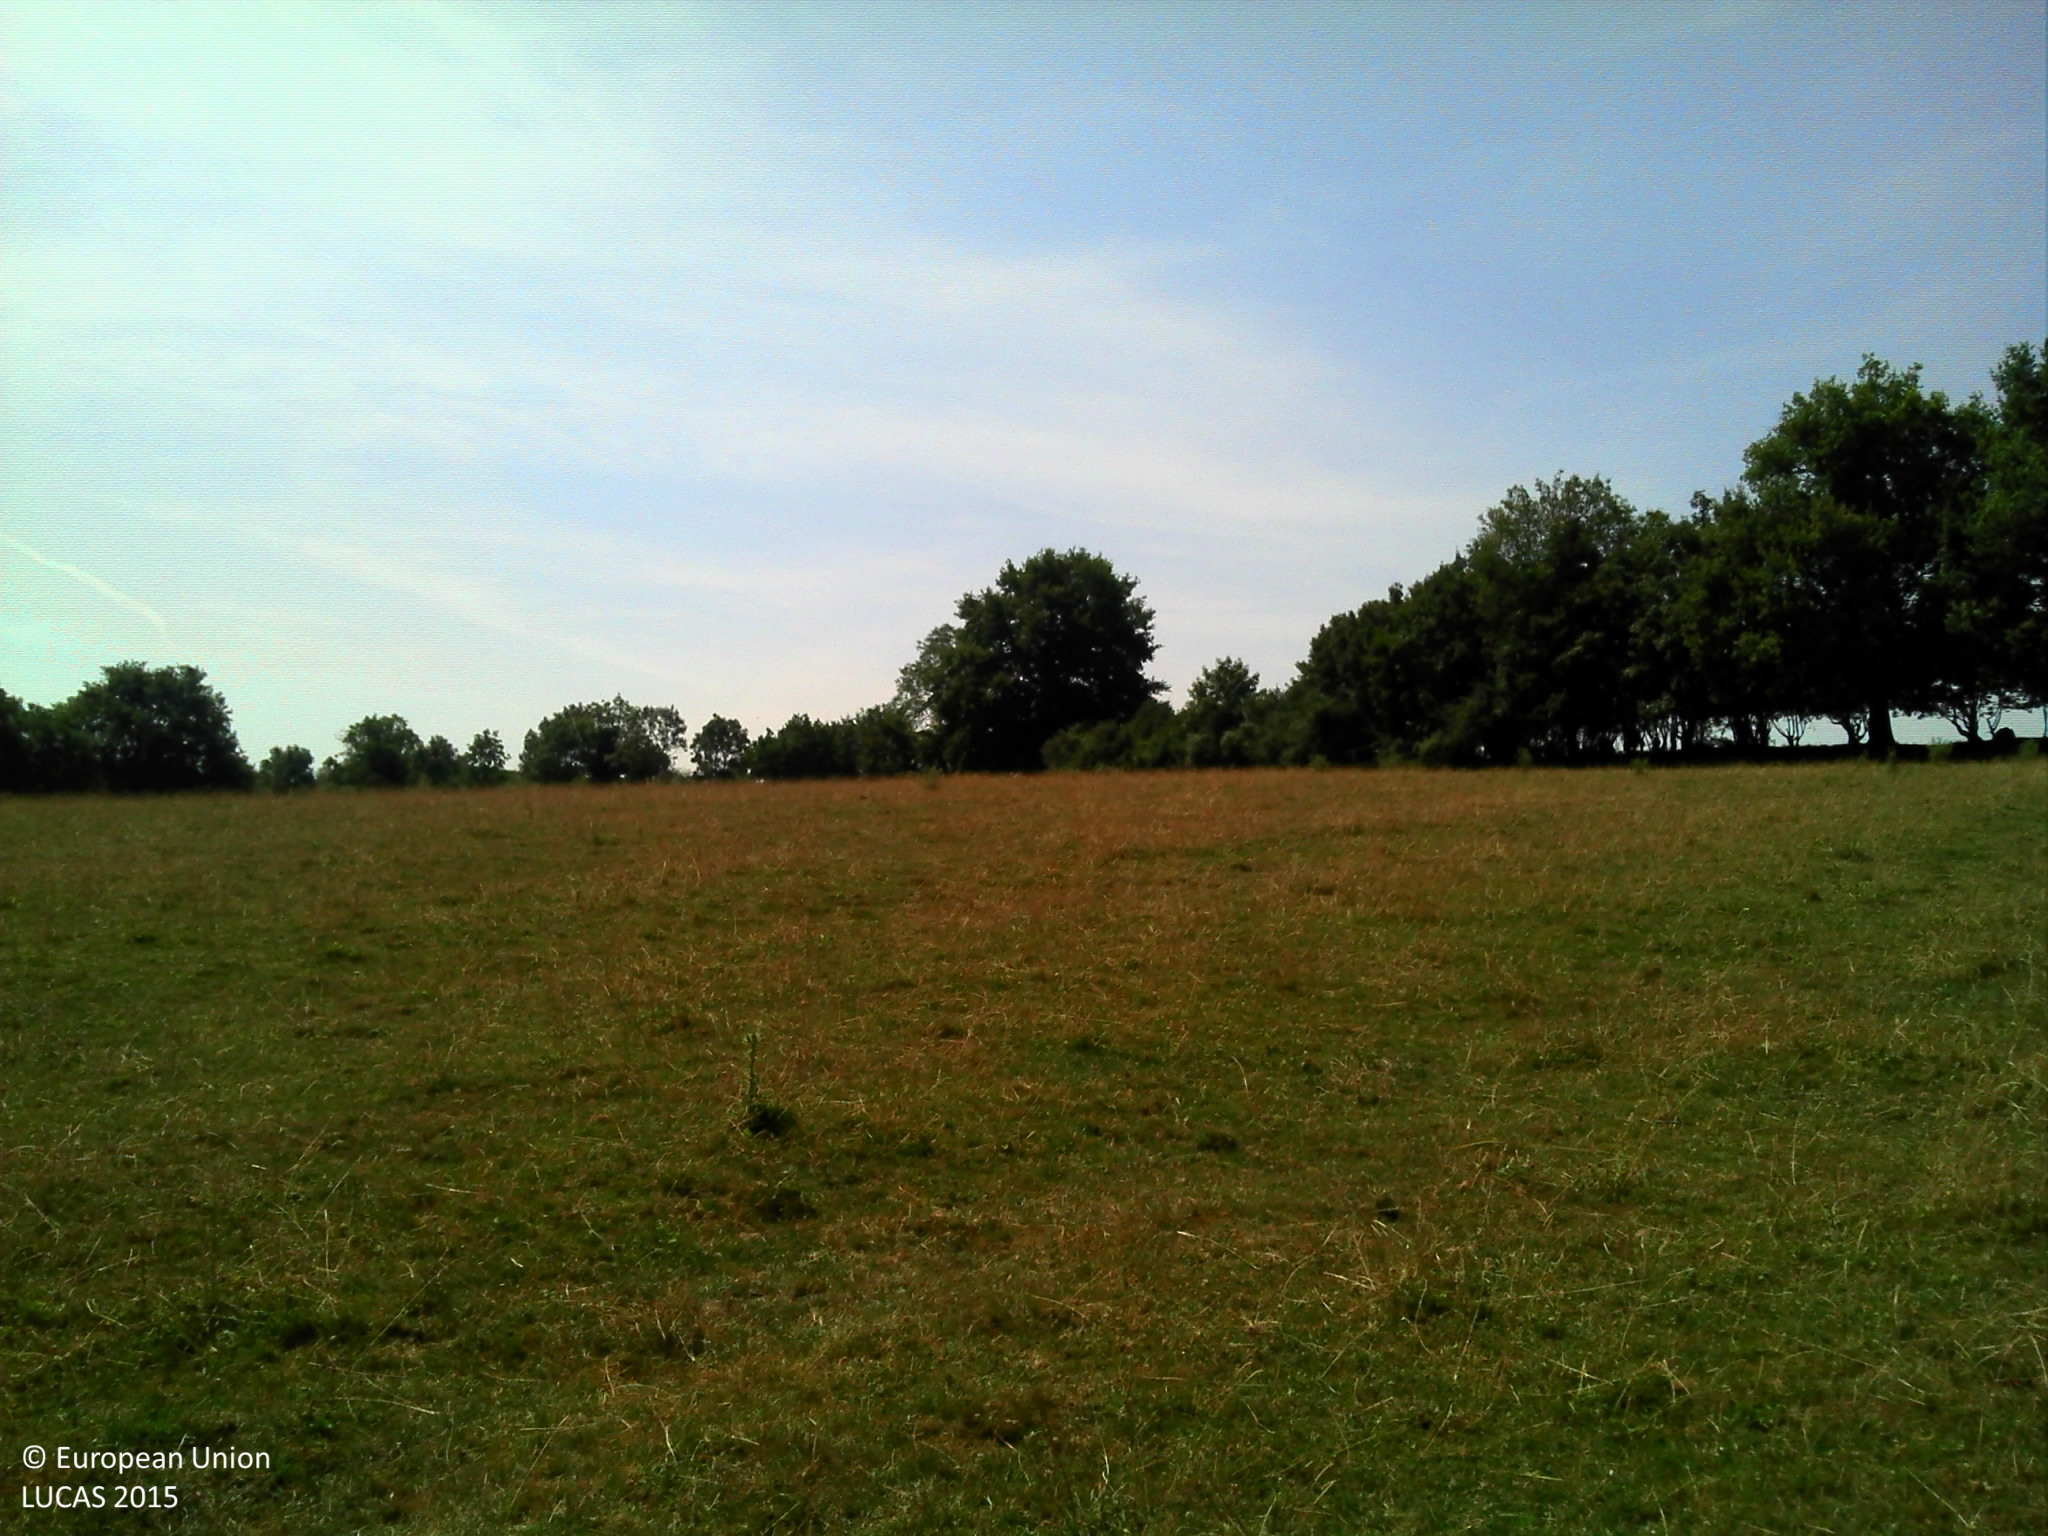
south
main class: Grassland
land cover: Grassland without tree/shrub cover
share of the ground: > 75 %
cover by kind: herbaceous plants 100 %
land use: Agriculture (excluding fallow land and kitchen gardens)
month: July
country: FR
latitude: 46.4851
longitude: 3.0280
